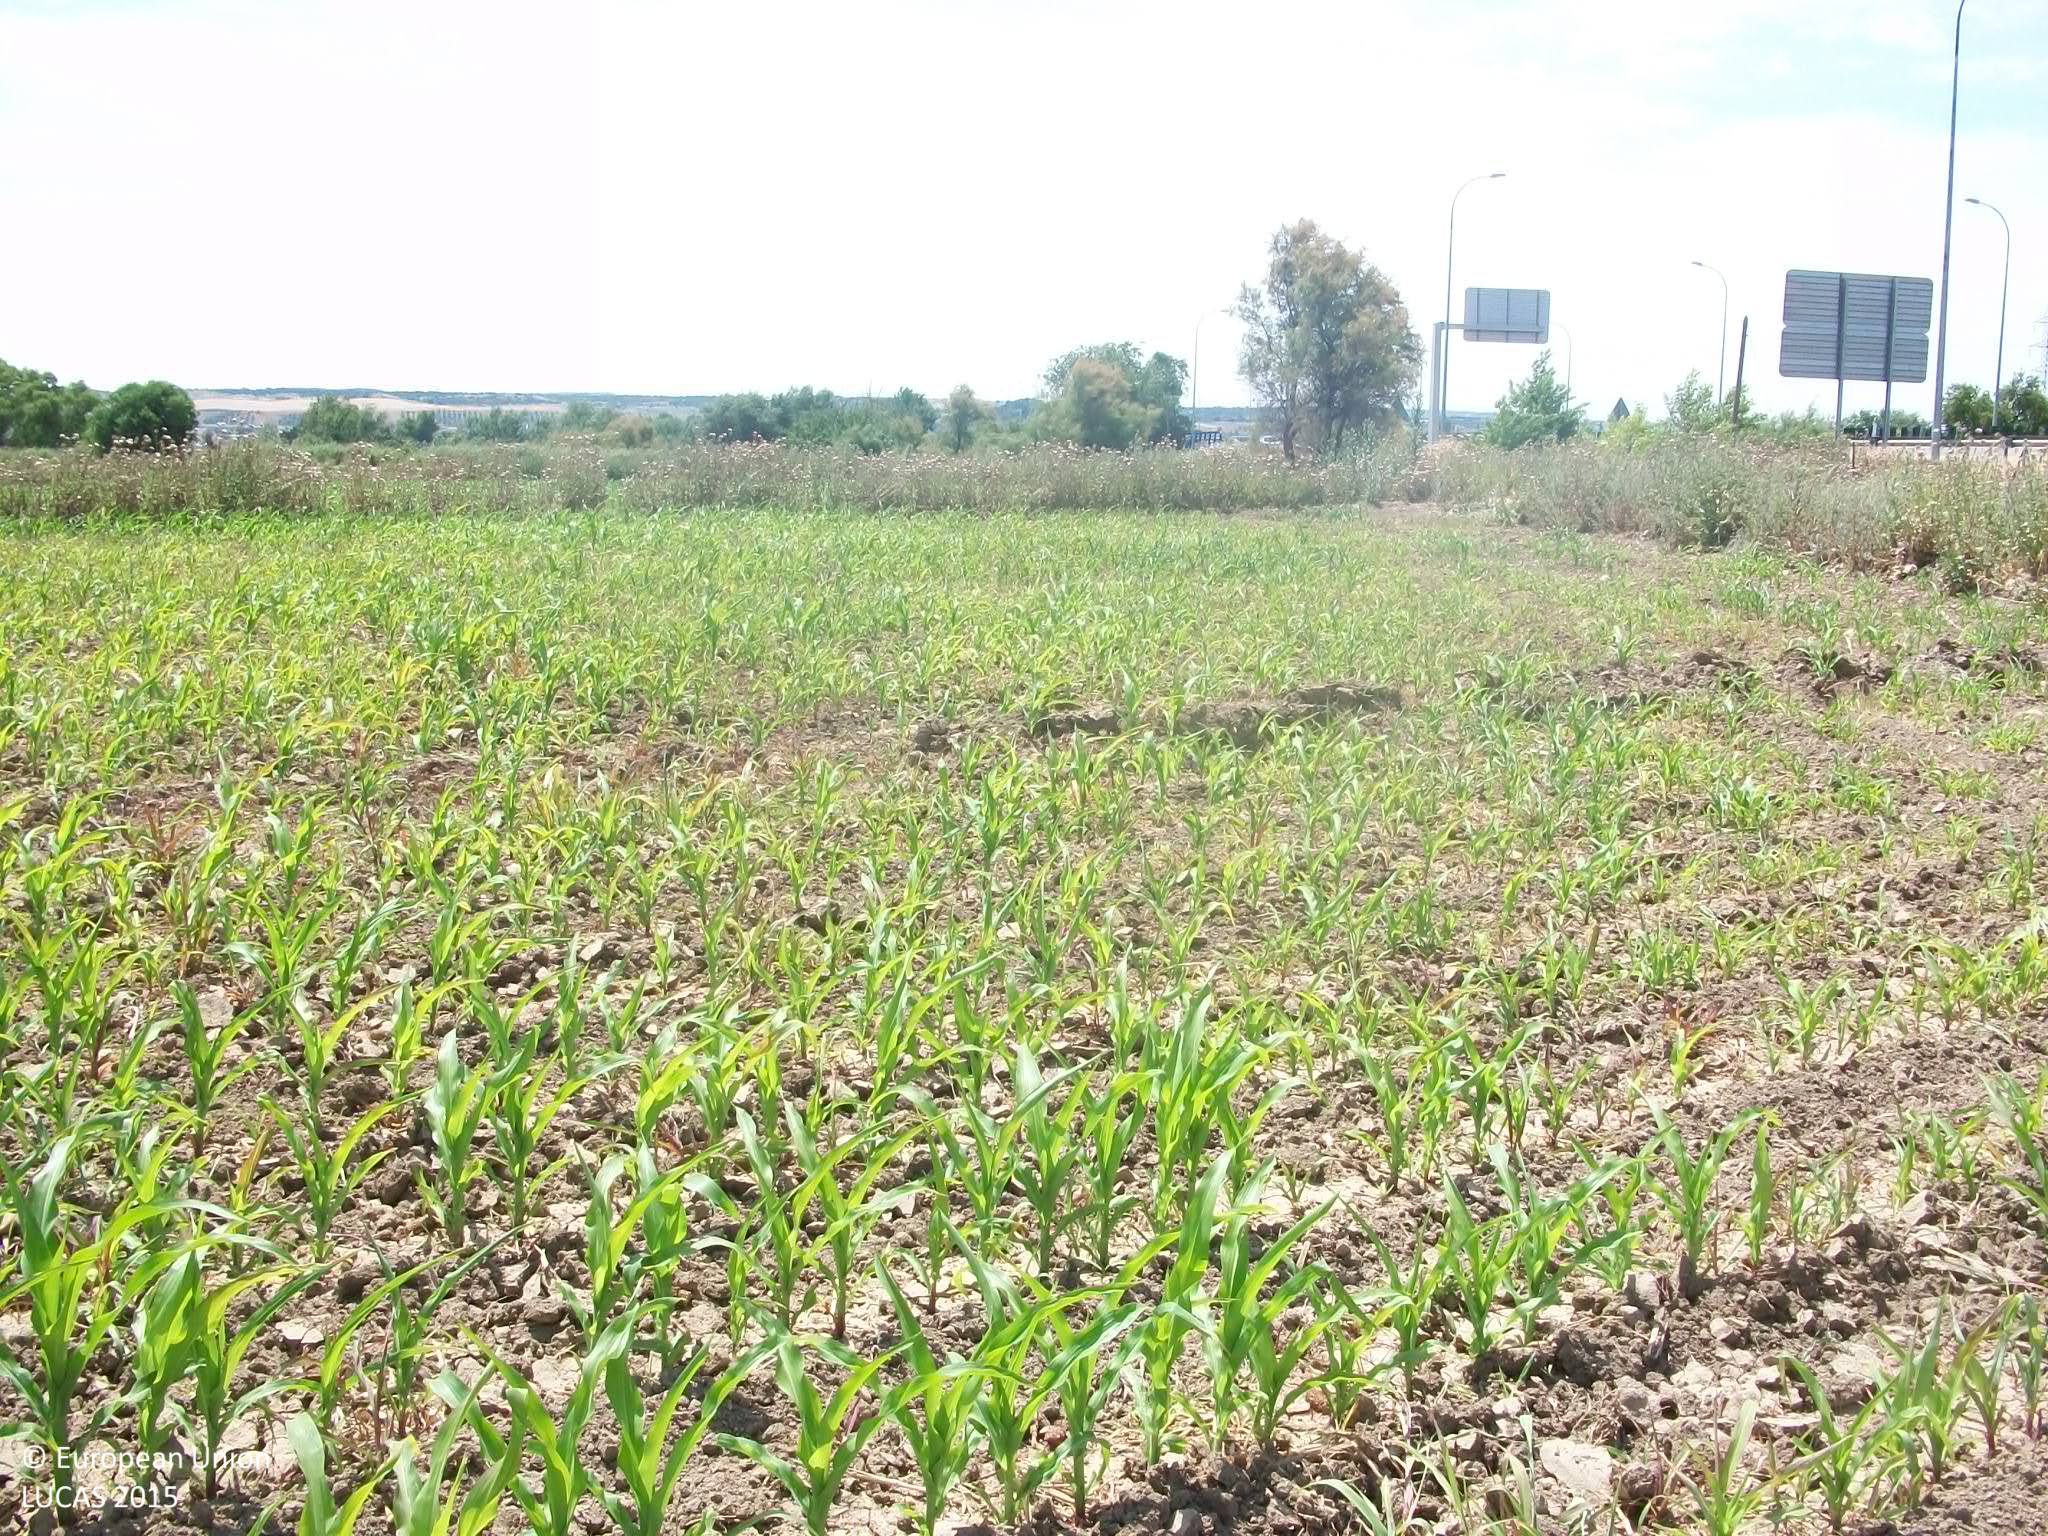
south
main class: Cropland
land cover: Maize
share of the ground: 50 - 75 %
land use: Agriculture (excluding fallow land and kitchen gardens)
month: May
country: ES
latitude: 40.0394
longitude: -3.6624
